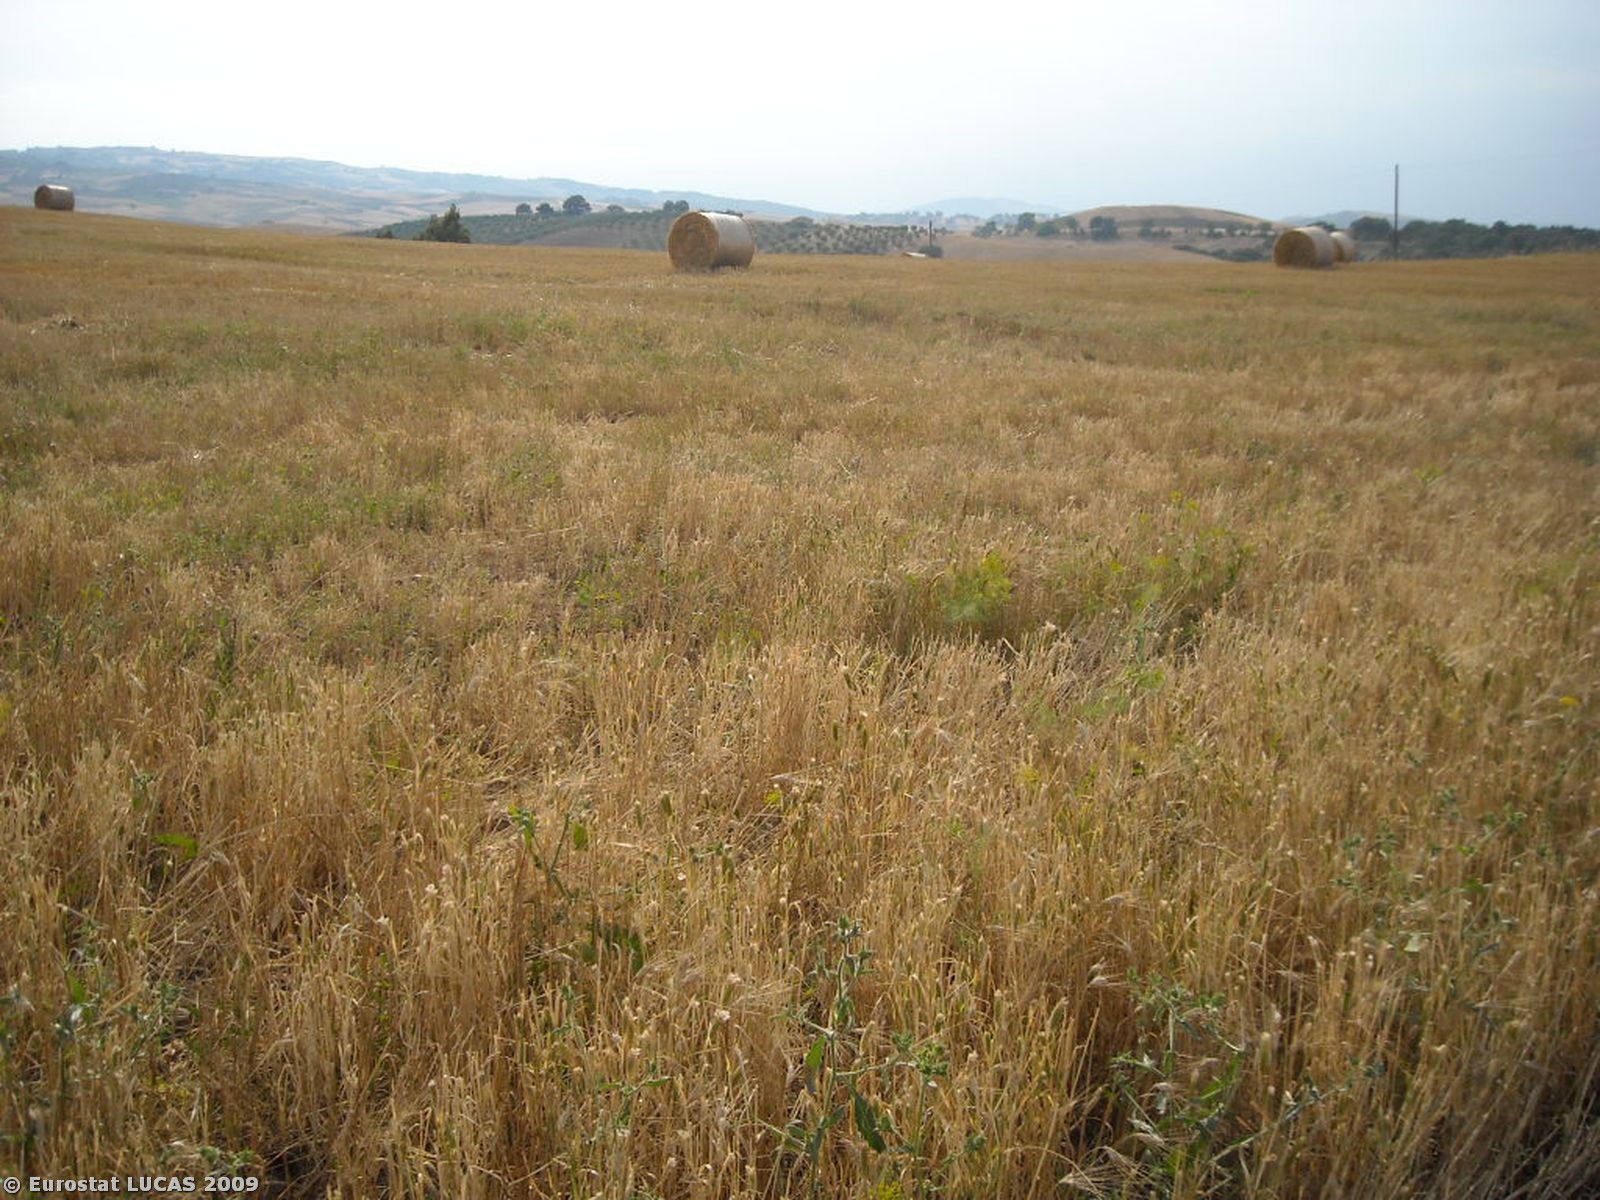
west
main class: Cropland
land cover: Durum wheat
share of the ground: < 10 %
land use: Agriculture (excluding fallow land and kitchen gardens)
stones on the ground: < 10 %
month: July
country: IT
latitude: 40.6916
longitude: 16.1427
